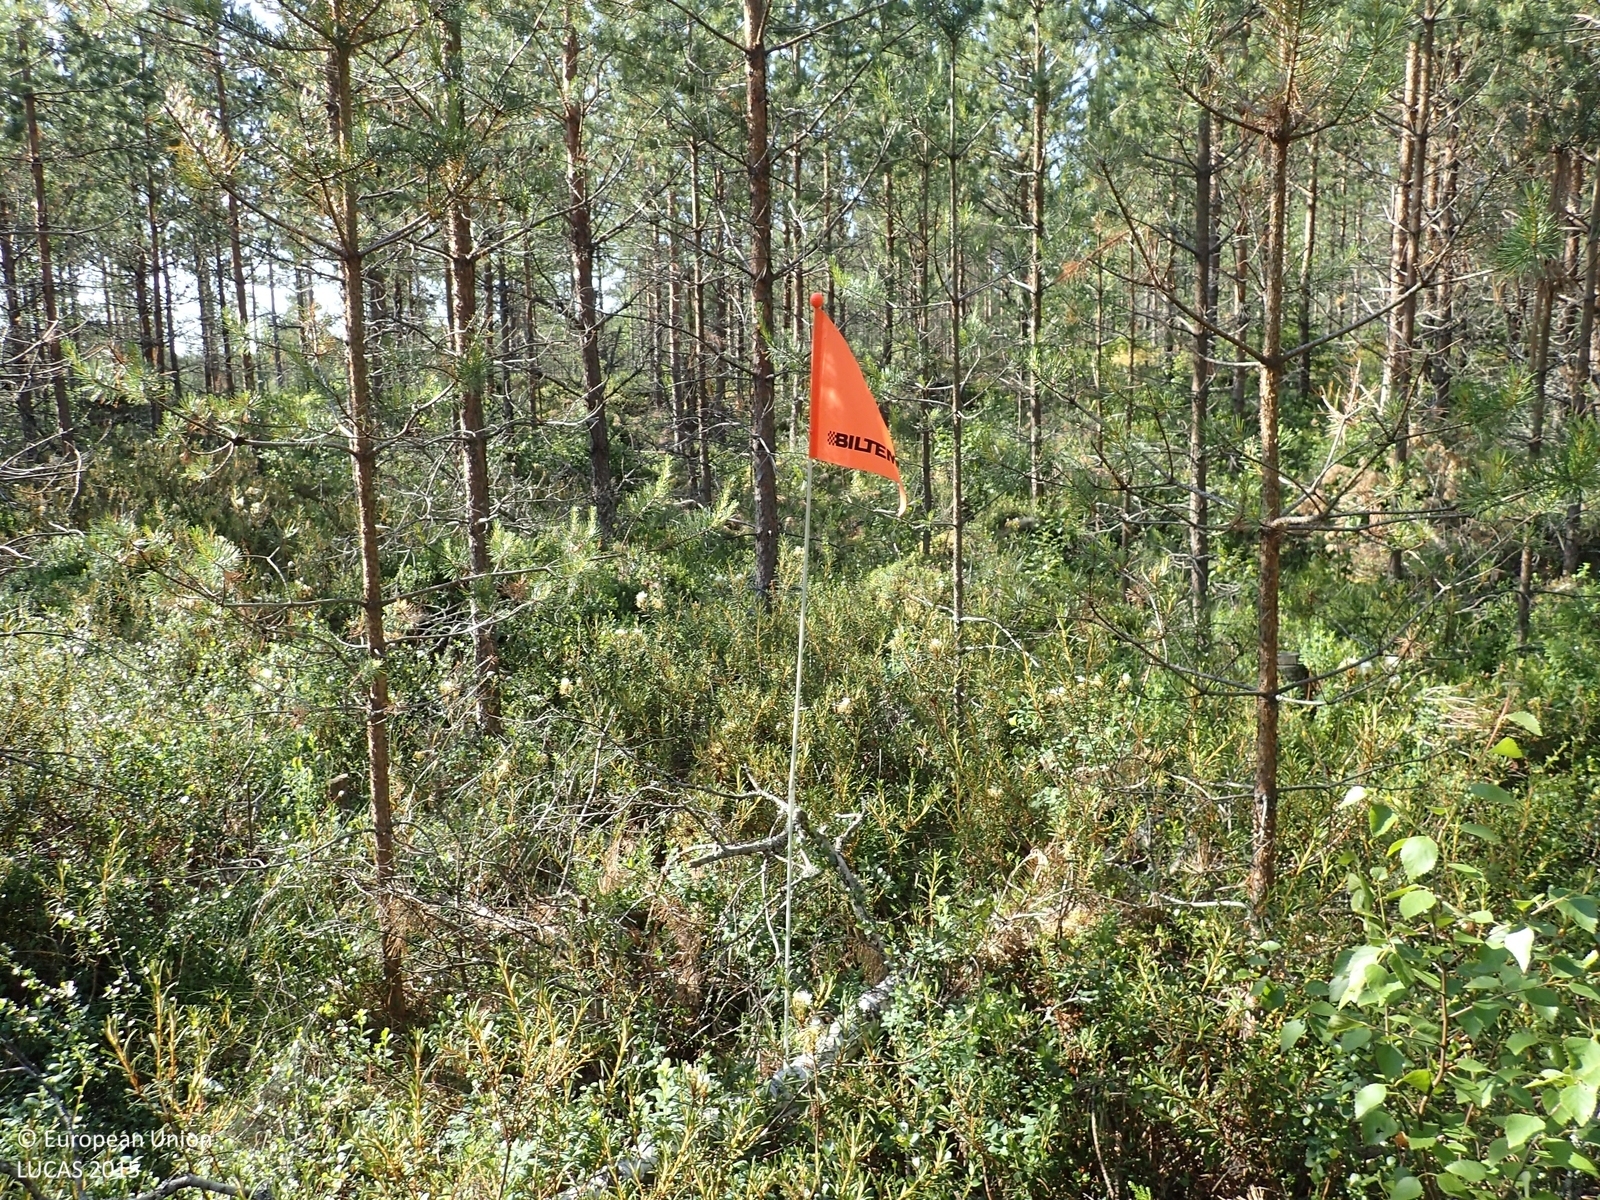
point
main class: Woodland
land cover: Pine dominated coniferous woodland
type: boreal forest
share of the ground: 50 - 75 %
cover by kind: coniferous forest trees 50 %, shrubs 50 %
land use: Forestry
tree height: < 5 m
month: July
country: FI
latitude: 62.7638
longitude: 21.6178
